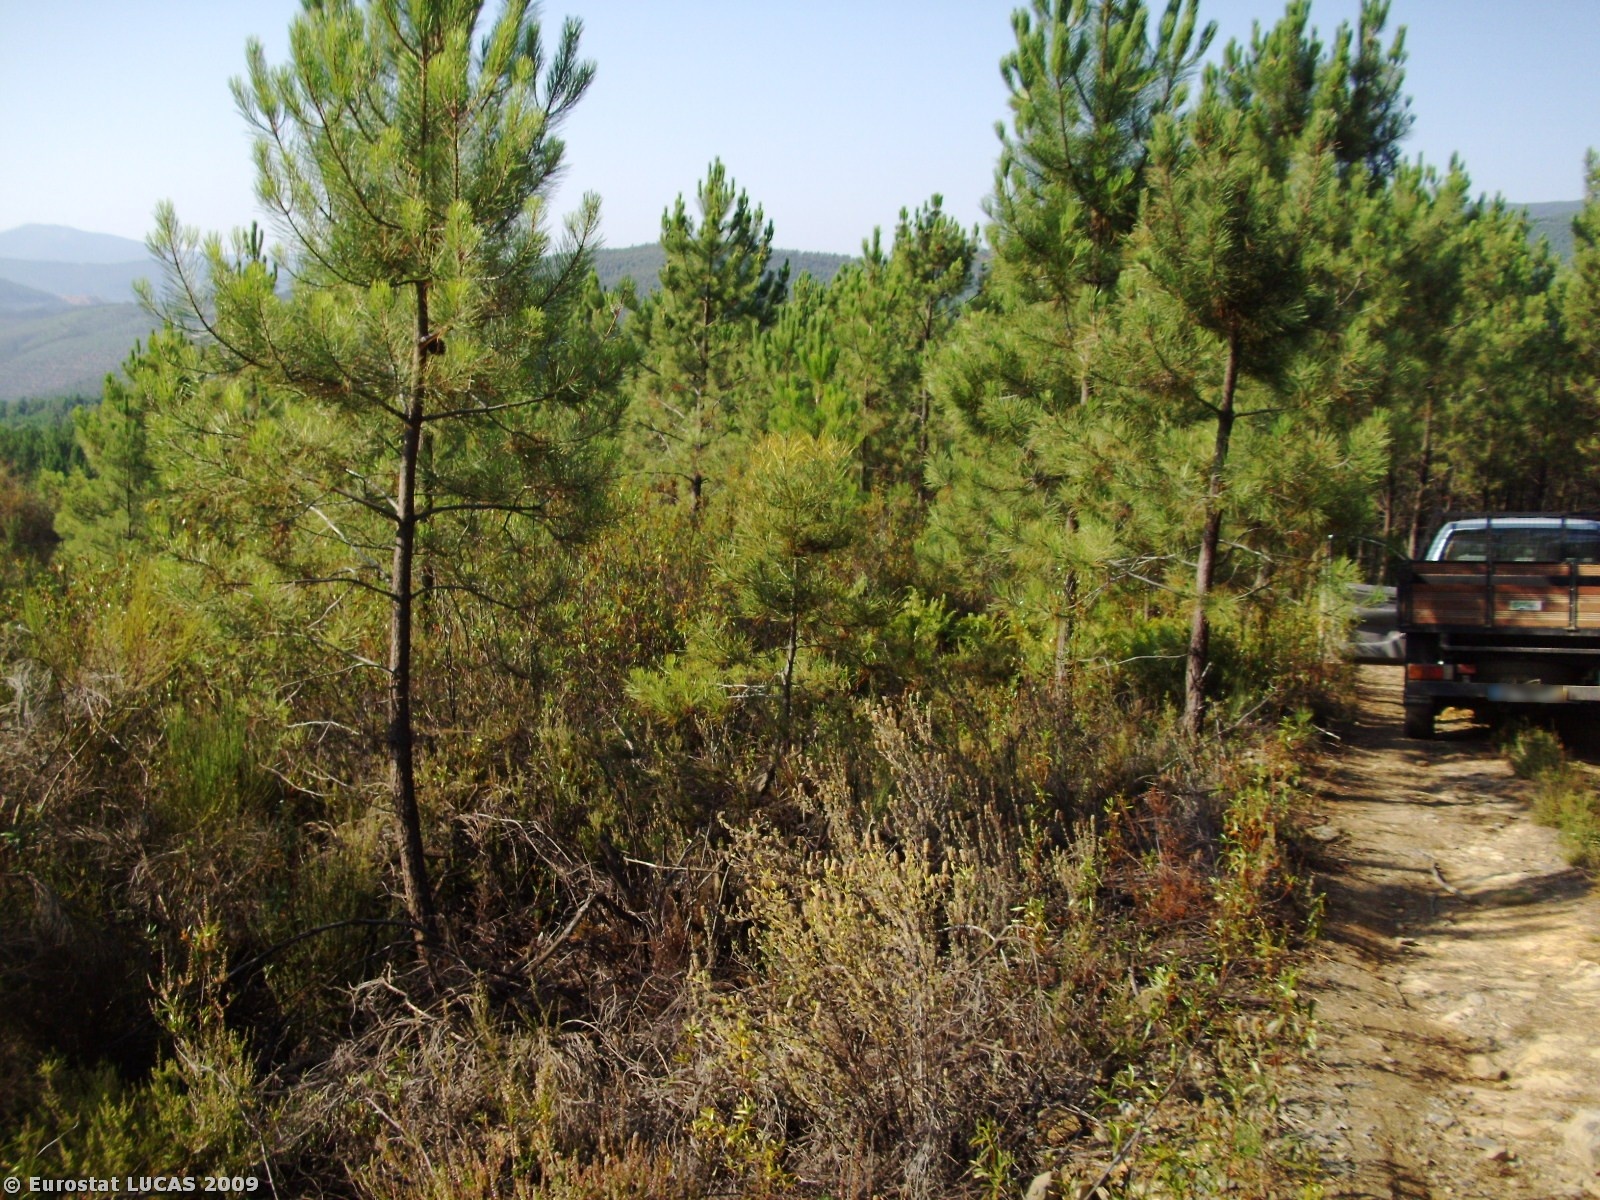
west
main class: Shrubland
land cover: Shrubland with sparse tree cover
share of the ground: > 75 %
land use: Unused
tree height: > 5 m
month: August
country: PT
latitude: 40.1737
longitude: -7.7136
